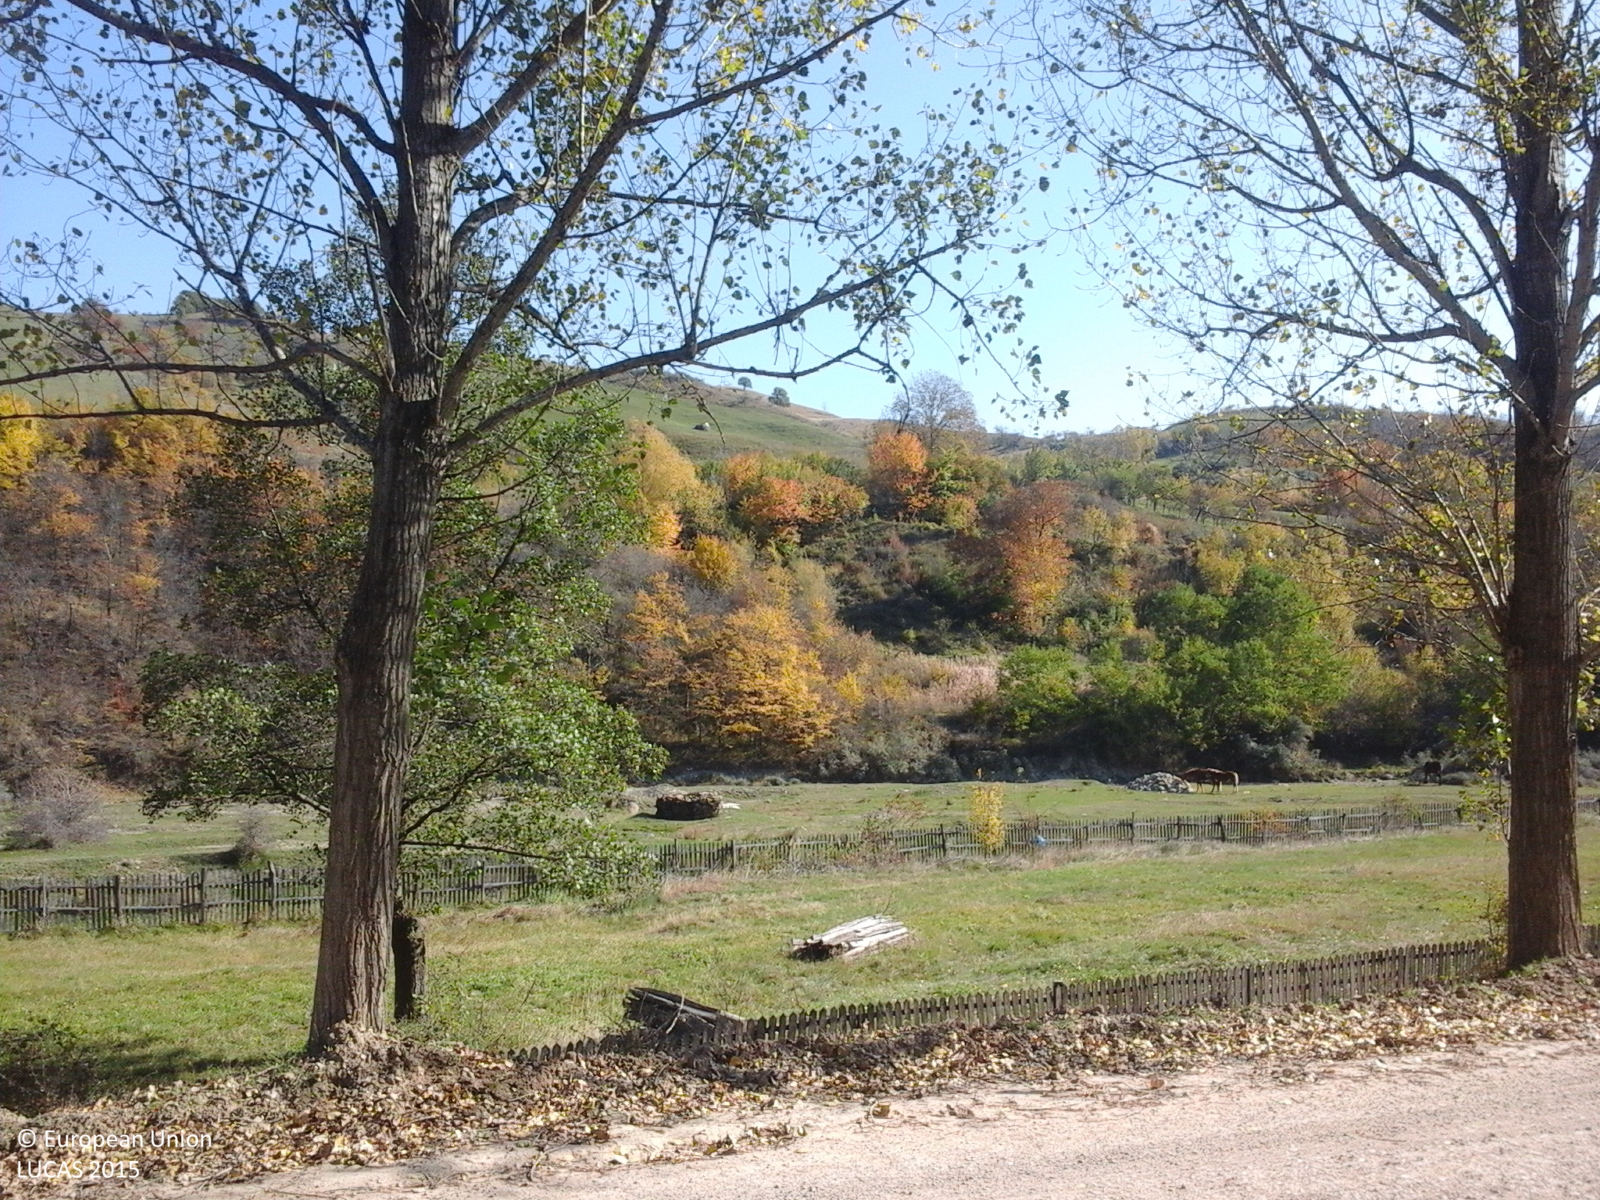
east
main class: Grassland
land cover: Grassland without tree/shrub cover
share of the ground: > 75 %
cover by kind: herbaceous plants 100 %
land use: Residential
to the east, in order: Grassland without tree/shrub cover; Lines of trees; Fences; Electric lines; Grass margins; Lines of trees; Grass margins; Paved roads, cycling and walking lanes; Grass margins; Lines of trees; Grassland without tree/shrub cover; Fences; Grassland without tree/shrub cover; Fences; Grassland without tree/shrub cover; Tracks; Grassland without tree/shrub cover; Rocks and stones; Inland fresh running water; Broadleaved woodland; Grassland without tree/shrub cover; Lines of trees; Grassland with sparse tree/shrub cover
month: October
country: RO
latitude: 45.4223
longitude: 26.5222
